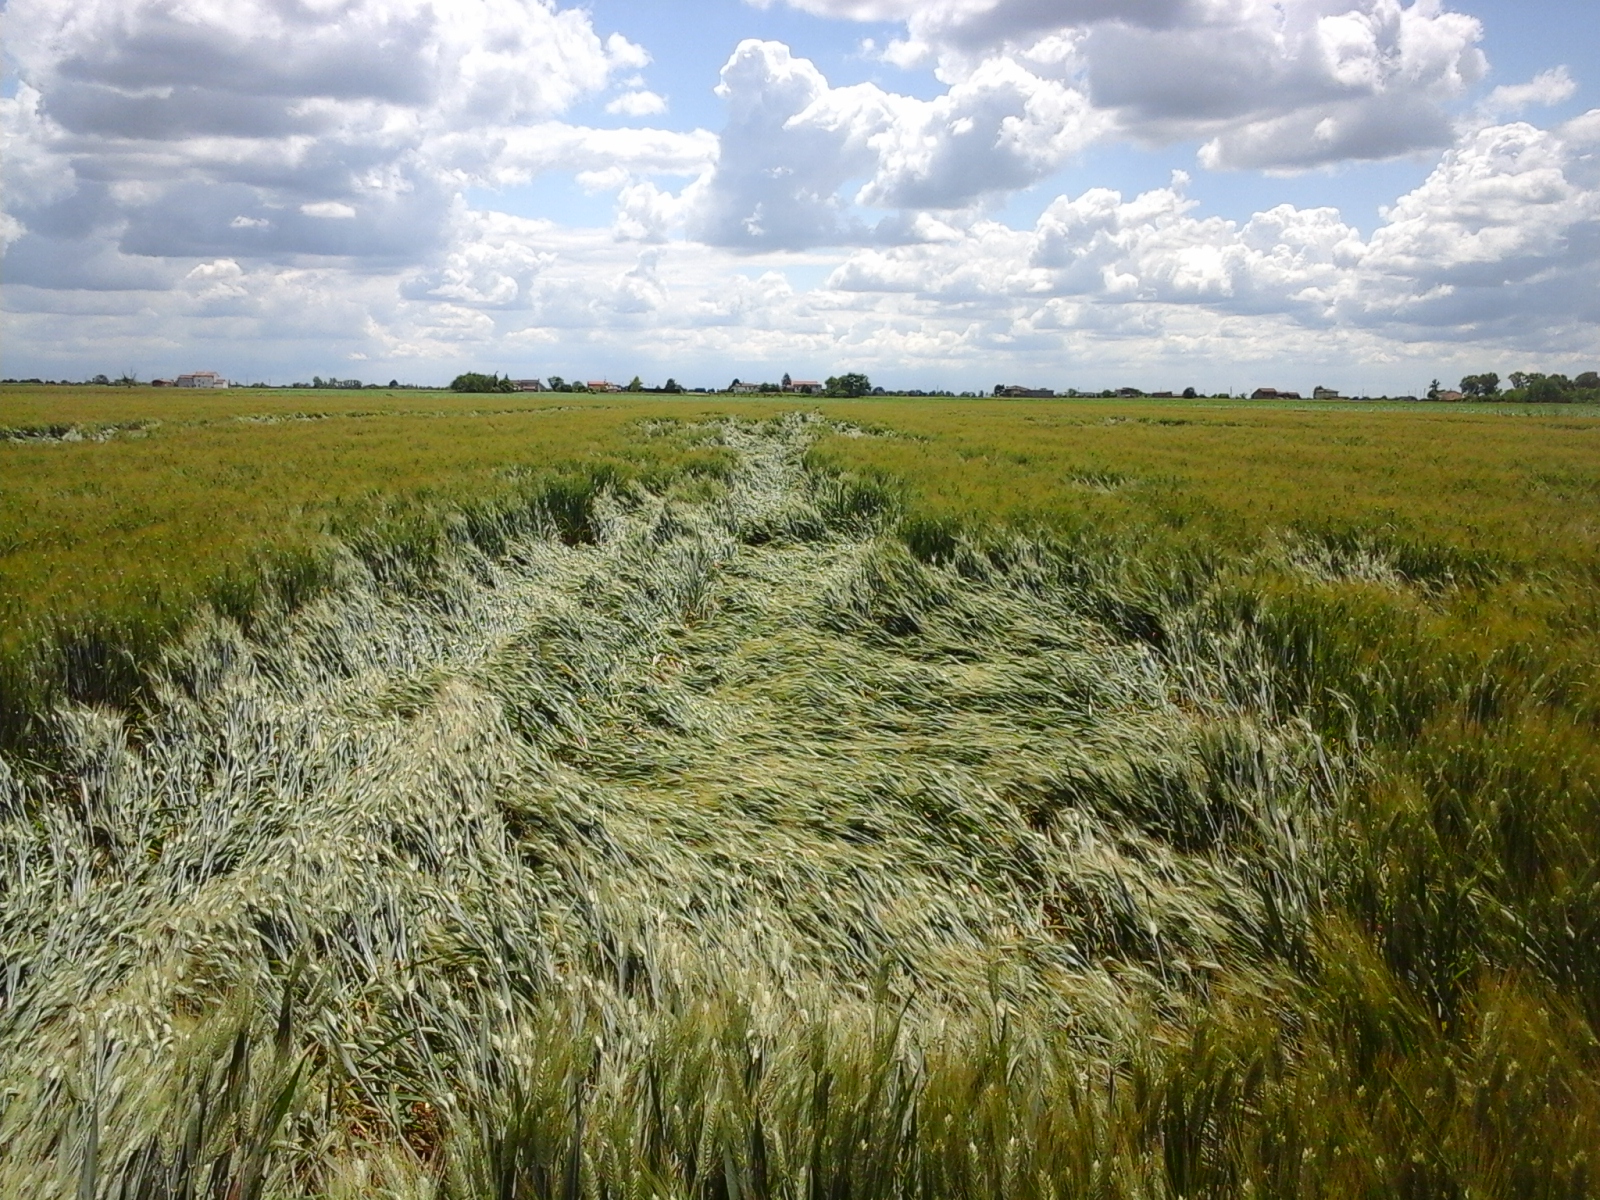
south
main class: Cropland
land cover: Durum wheat
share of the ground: > 75 %
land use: Agriculture (excluding fallow land and kitchen gardens)
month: May
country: IT
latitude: 45.0414
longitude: 11.6093
